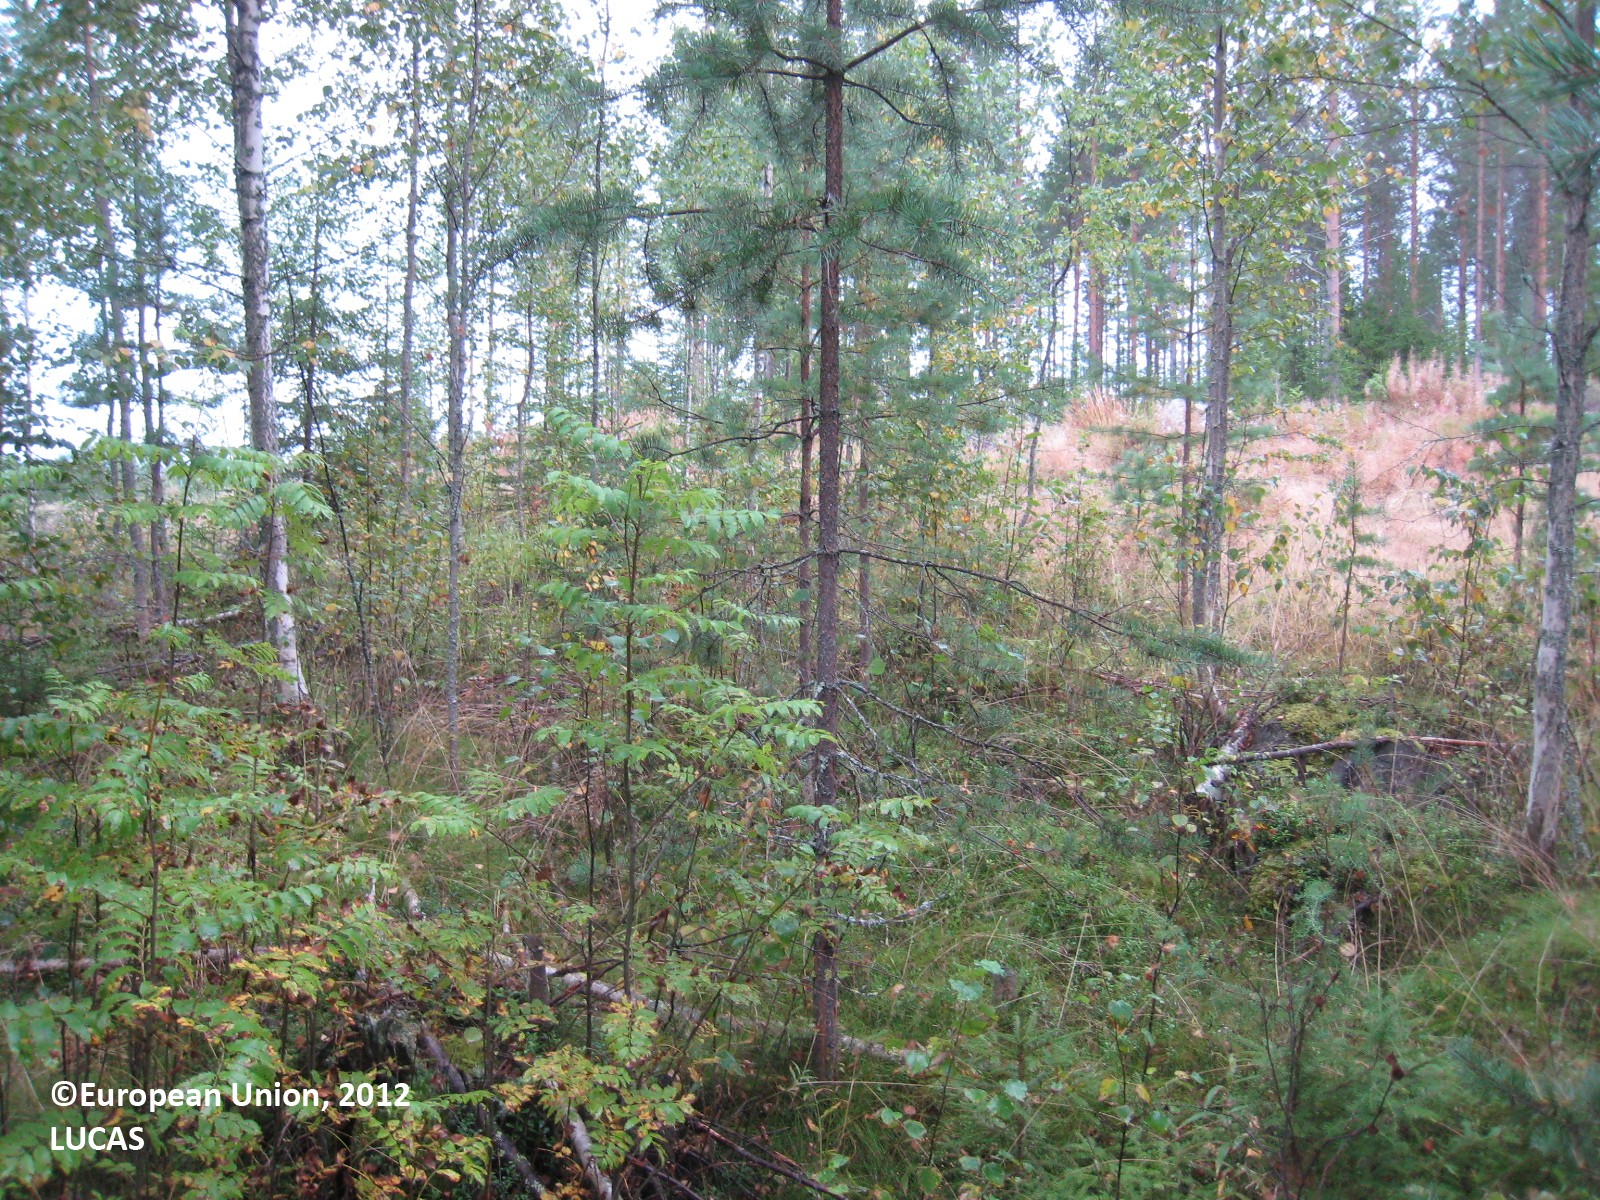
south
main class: Woodland
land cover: Pine dominated mixed woodland
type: boreal forest
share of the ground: > 75 %
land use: Forestry
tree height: > 5 m
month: August
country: FI
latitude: 62.1459
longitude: 27.2182
